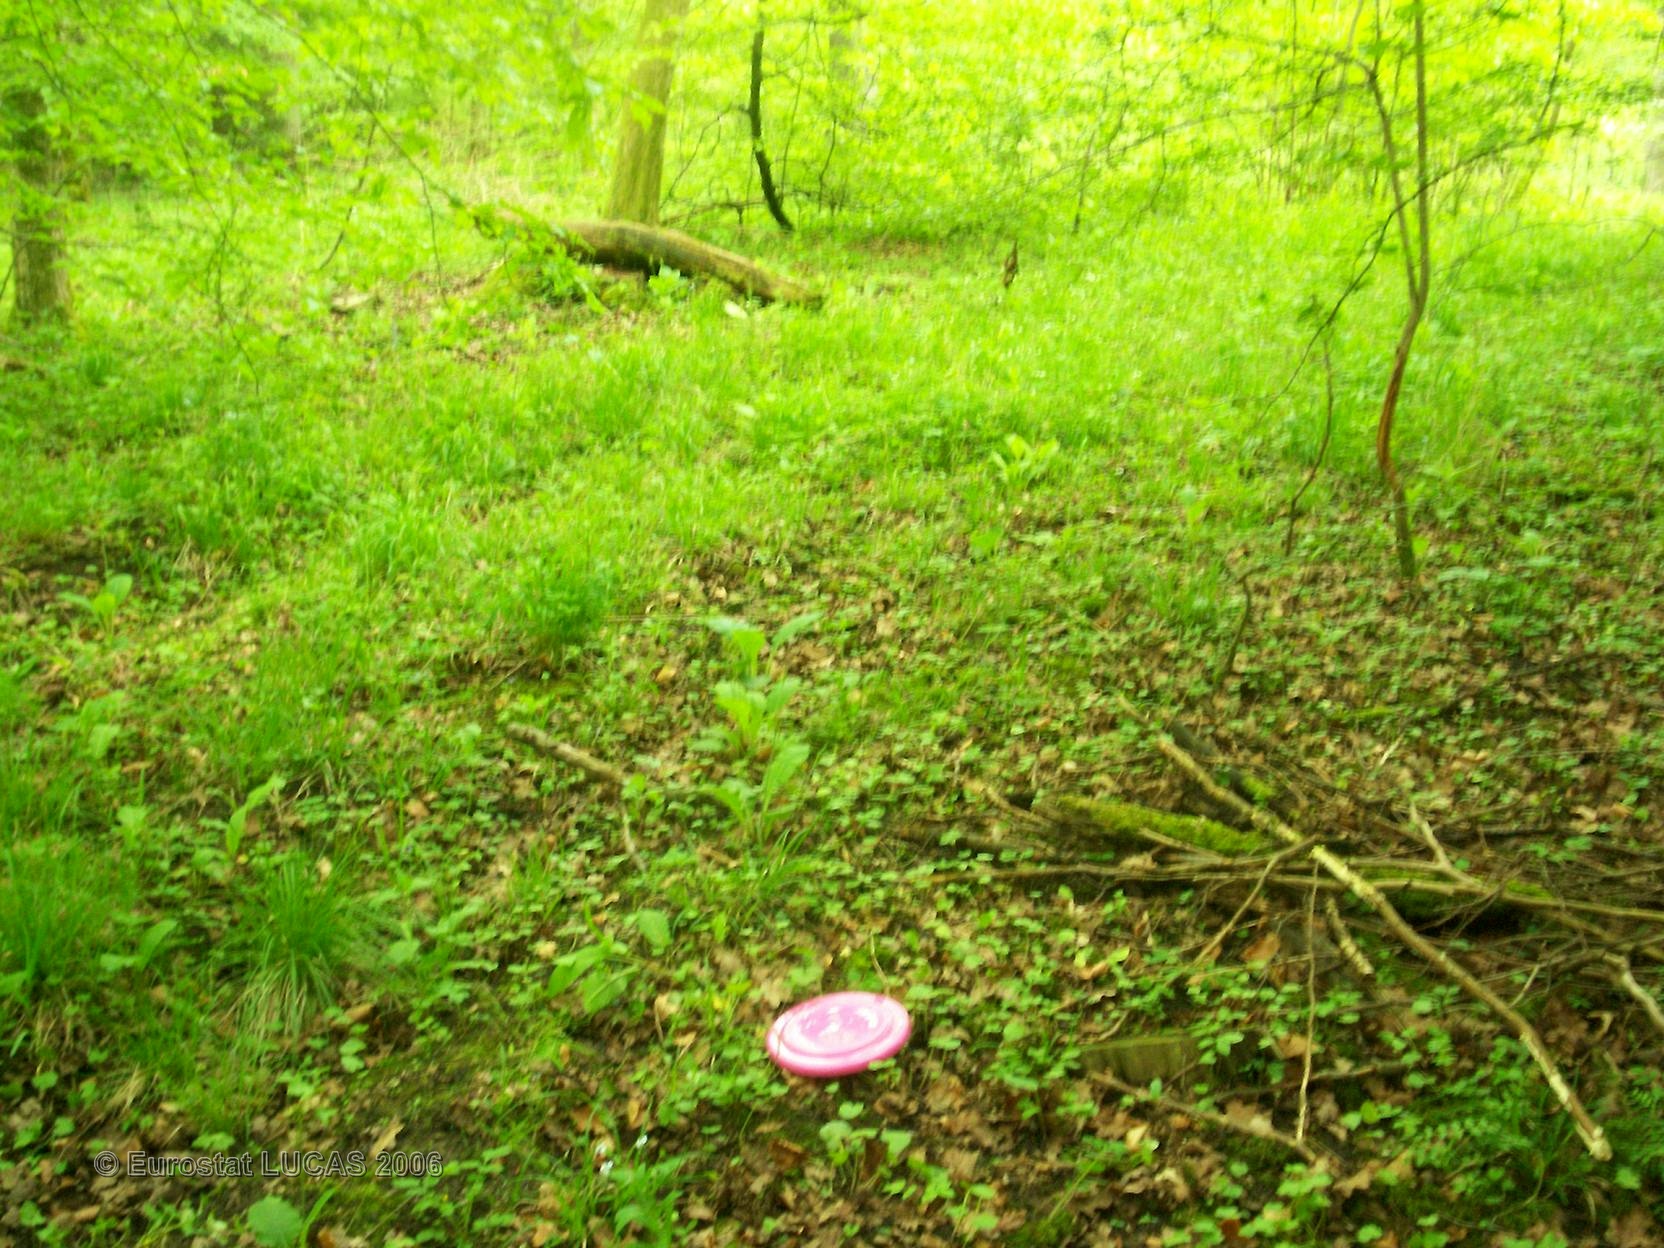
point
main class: Woodland
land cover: Mixed forest
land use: Forestry
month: May
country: FR
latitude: 49.3904
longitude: 6.4316
